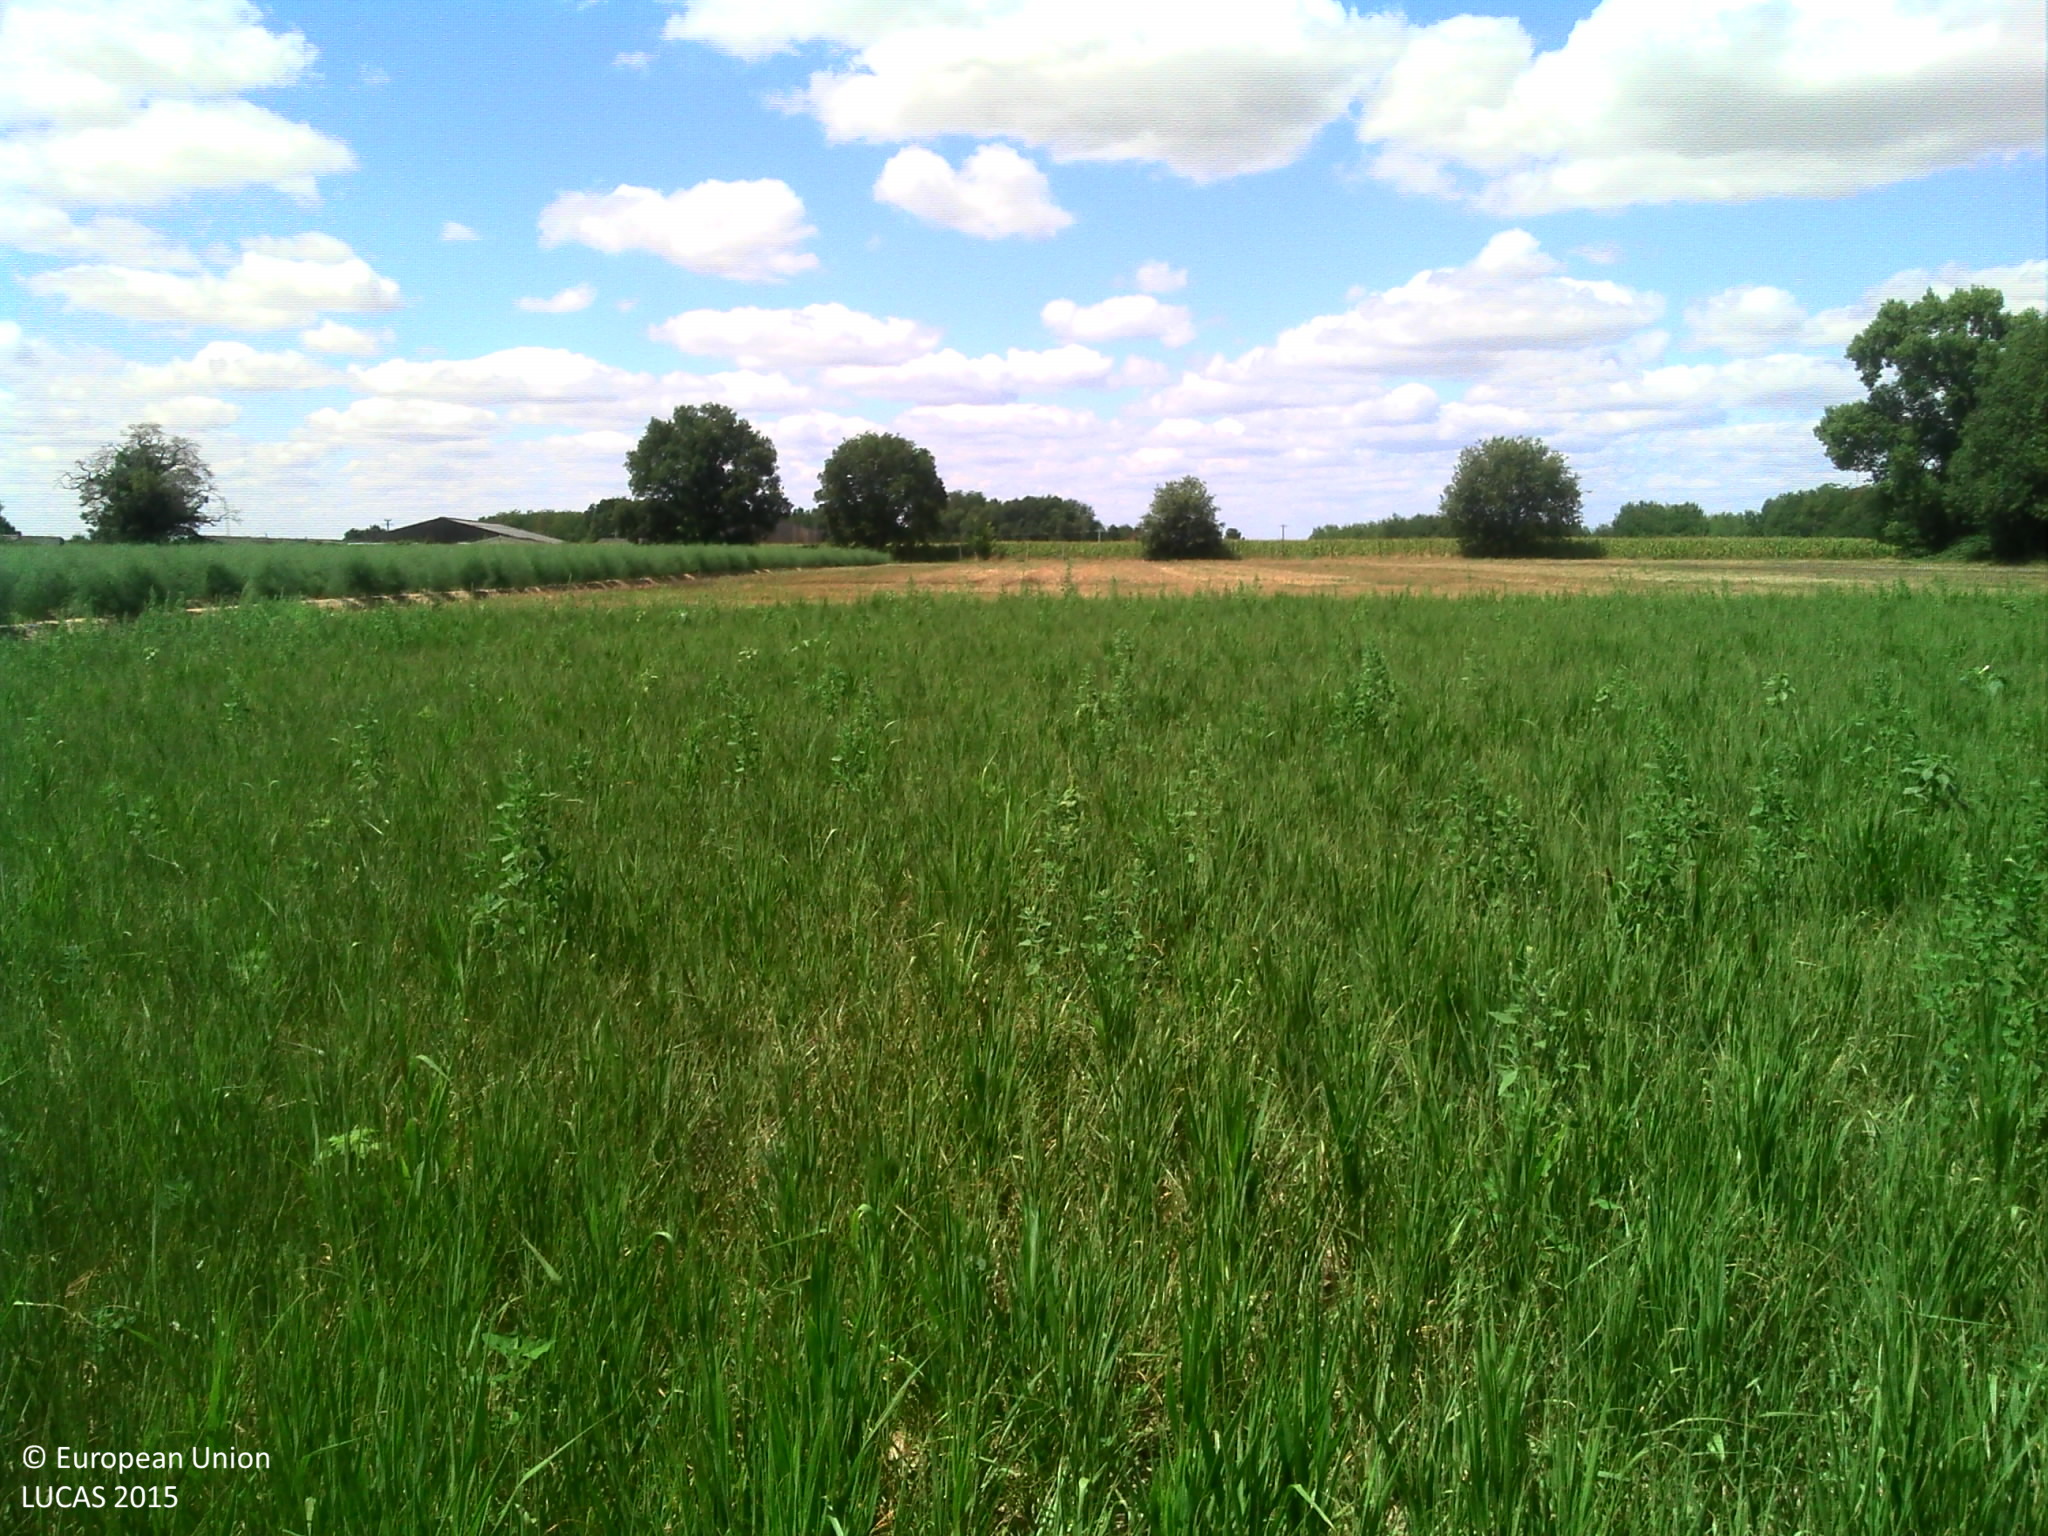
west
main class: Cropland
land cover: Temporary grasslands
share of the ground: > 75 %
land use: Agriculture (excluding fallow land and kitchen gardens)
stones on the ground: < 10 %
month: July
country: FR
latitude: 47.0412
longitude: 0.3848
